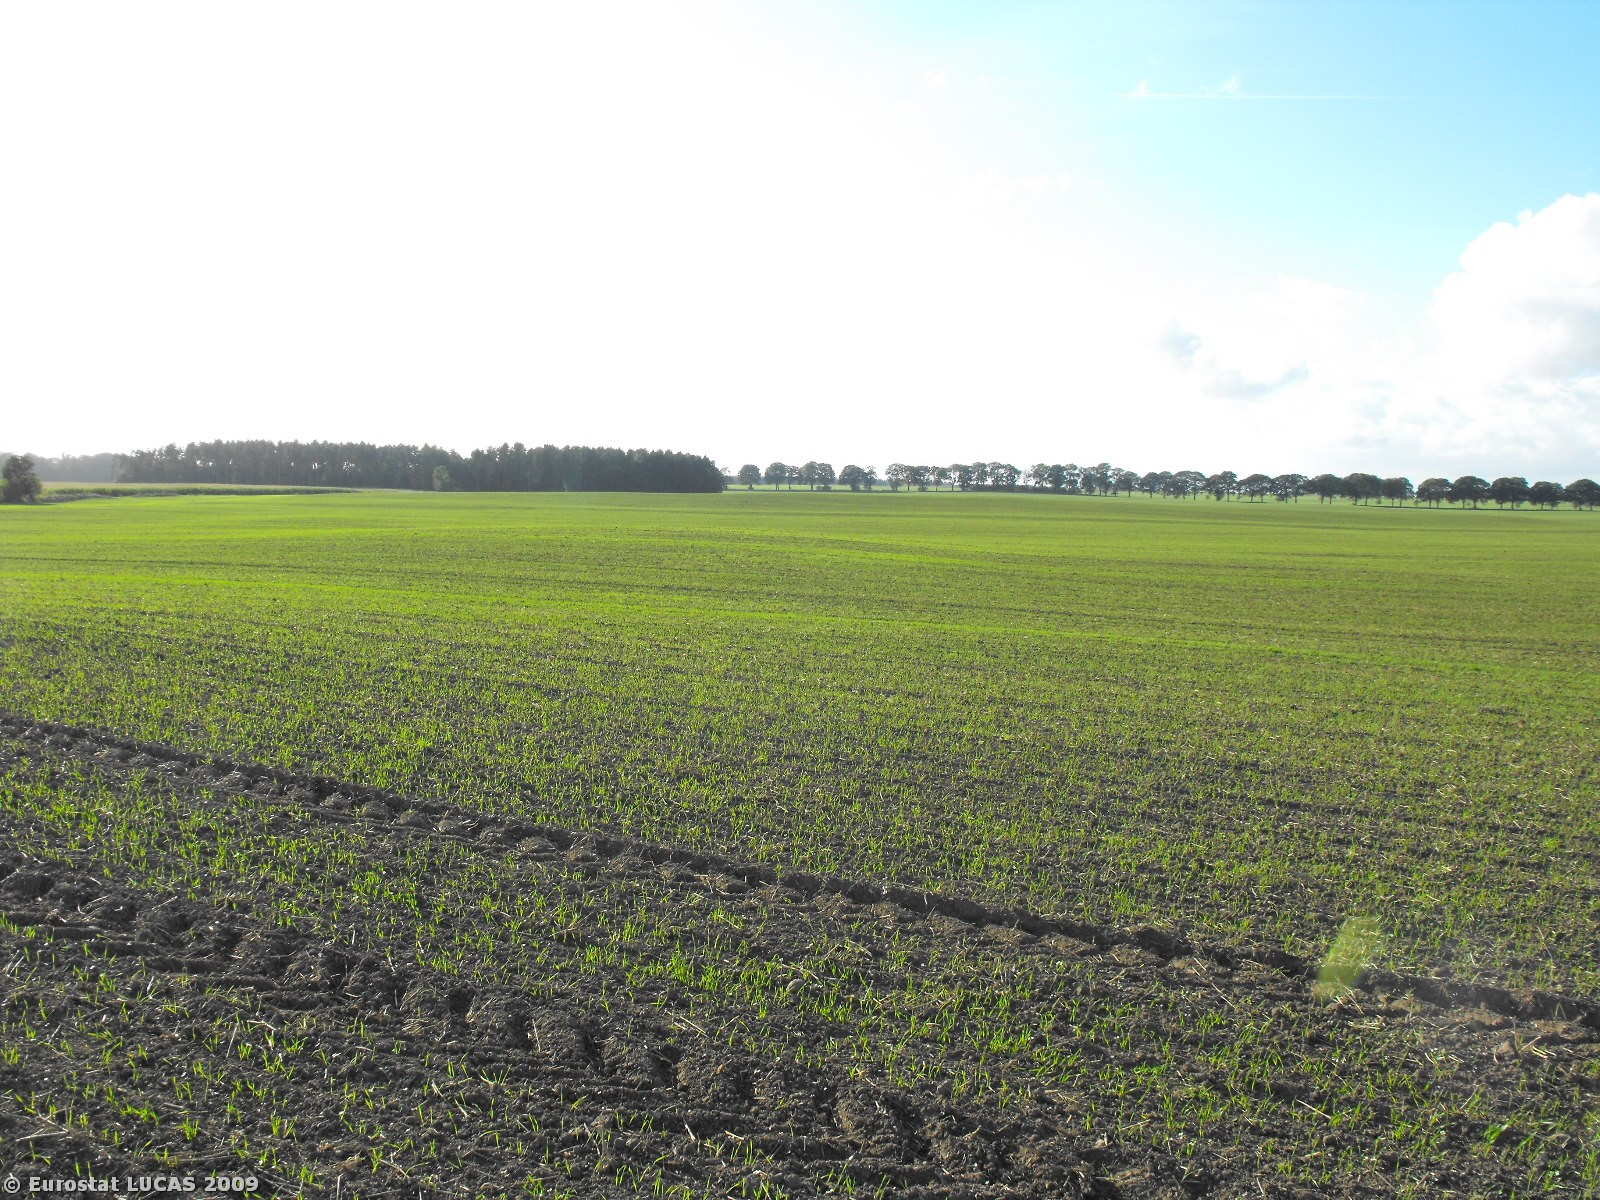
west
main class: Cropland
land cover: Common wheat
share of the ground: < 10 %
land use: Agriculture (excluding fallow land and kitchen gardens)
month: September
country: PL
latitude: 54.2846
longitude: 16.6269
